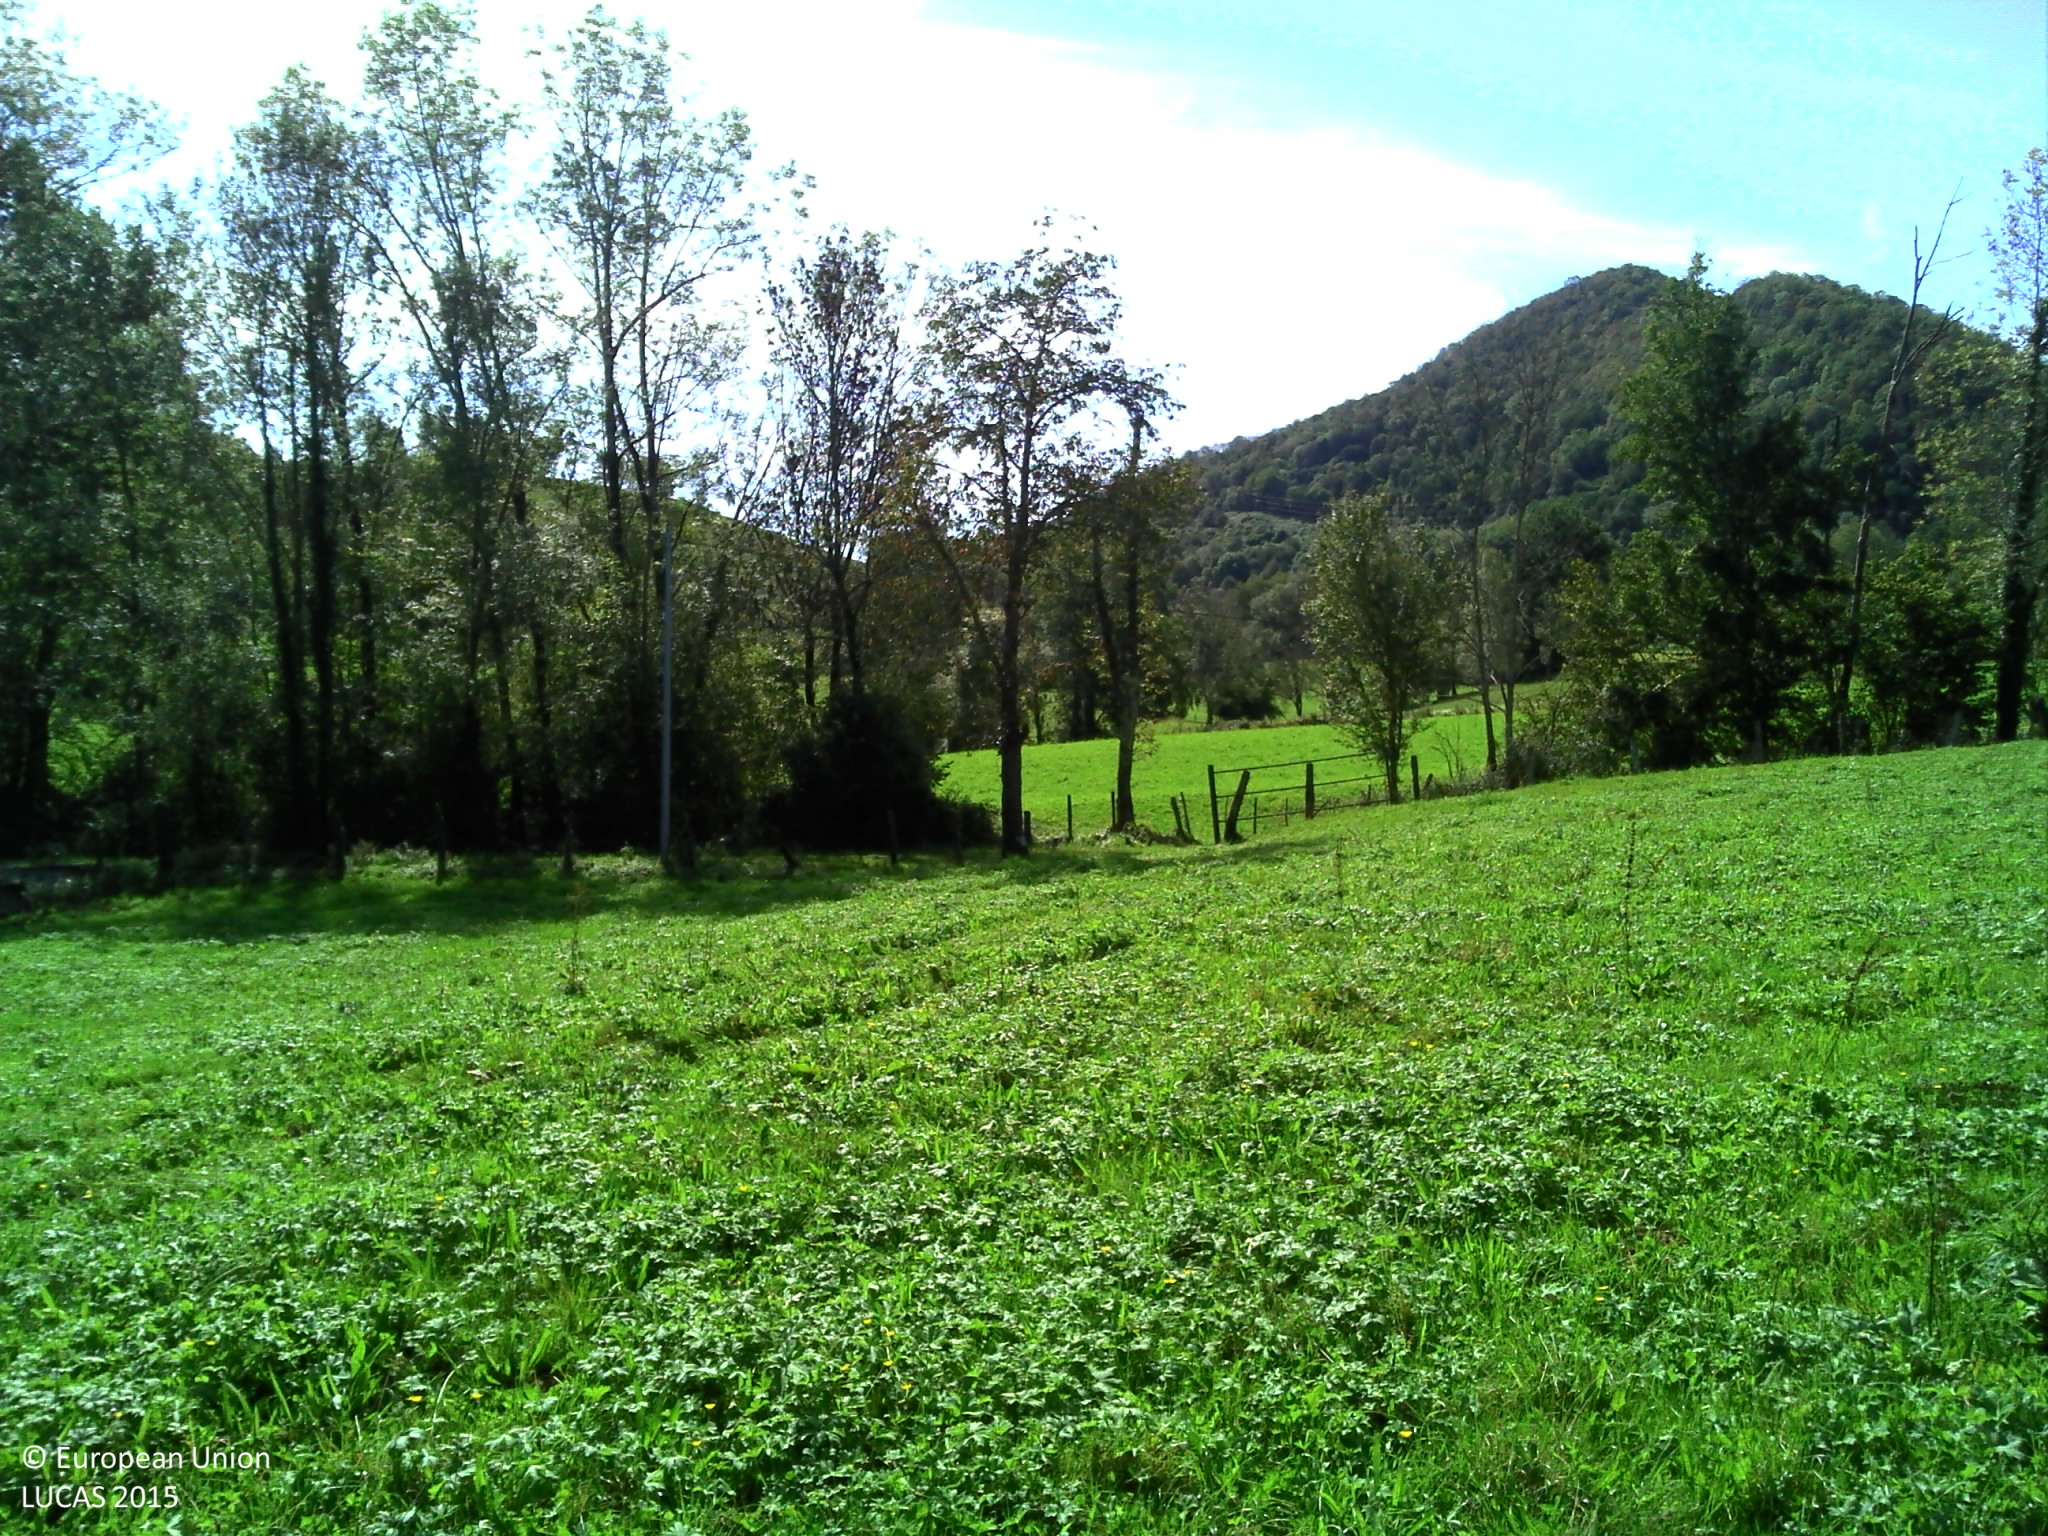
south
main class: Grassland
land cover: Grassland without tree/shrub cover
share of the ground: > 75 %
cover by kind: herbaceous plants 100 %
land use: Agriculture (excluding fallow land and kitchen gardens)
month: September
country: FR
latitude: 43.1316
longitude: -0.6164
